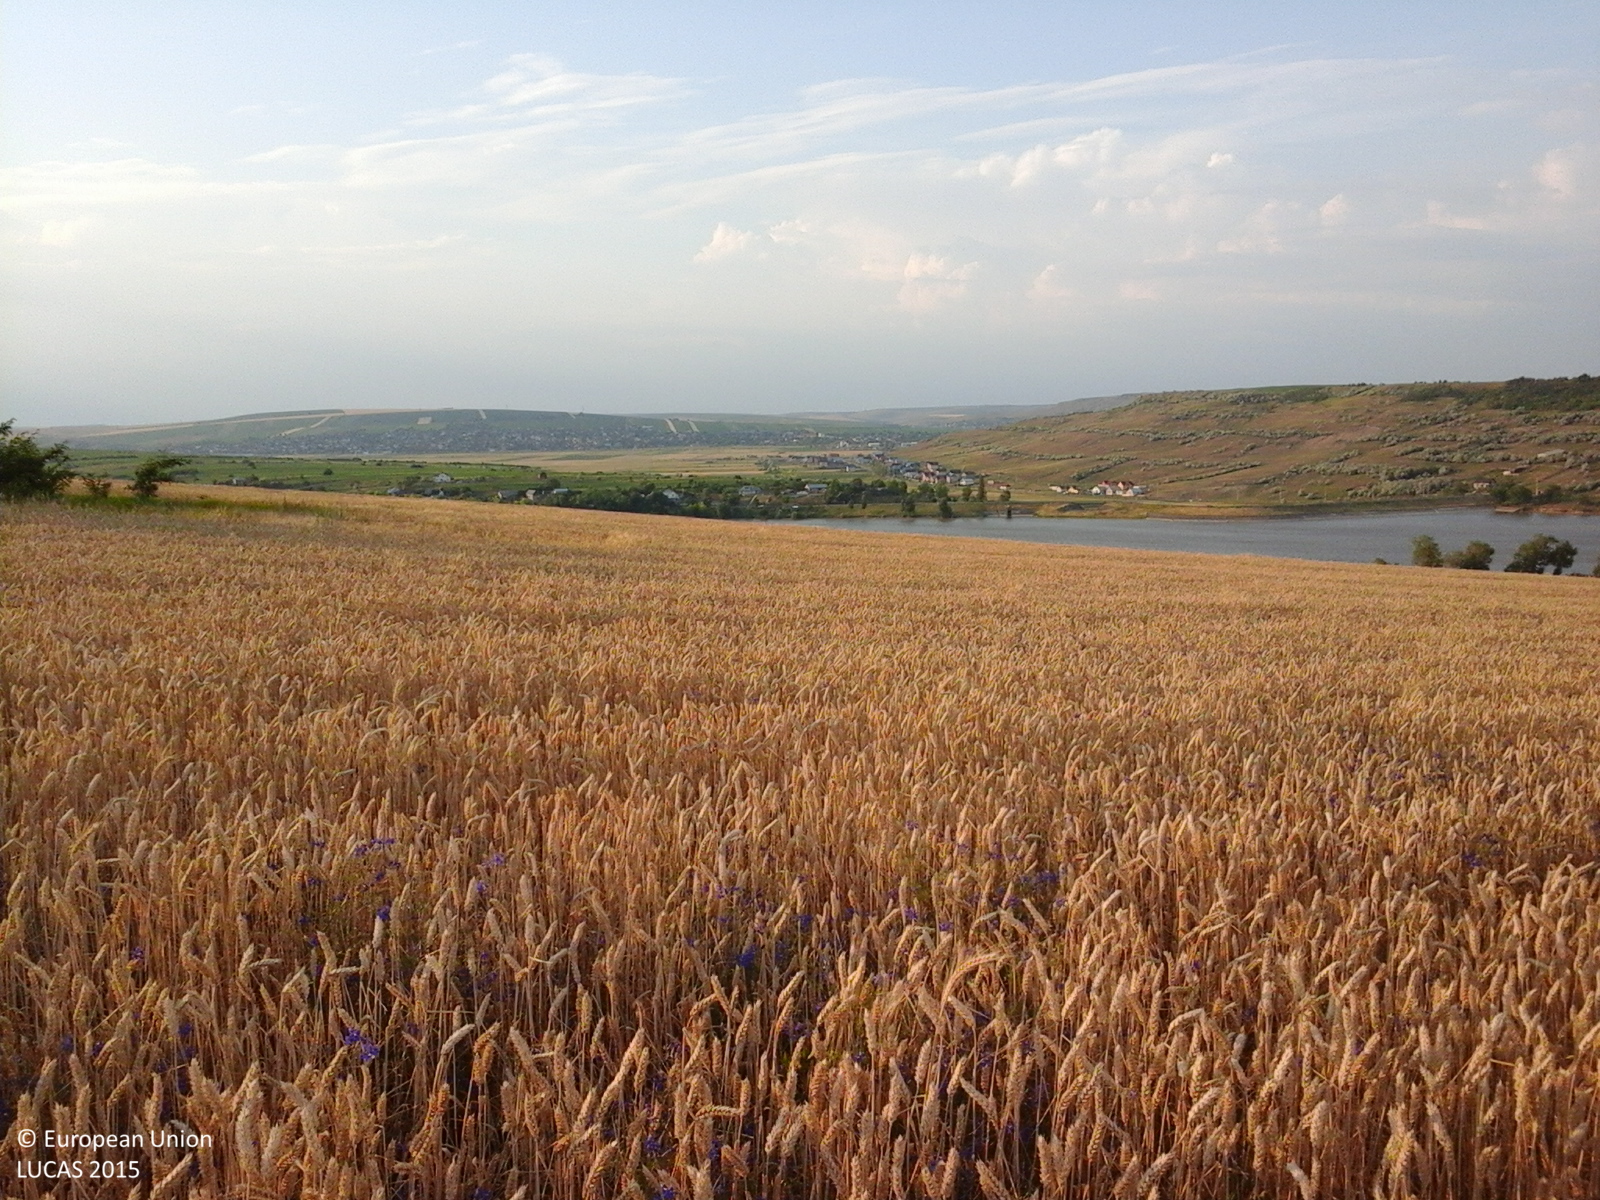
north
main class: Cropland
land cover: Common wheat
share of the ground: > 75 %
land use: Agriculture (excluding fallow land and kitchen gardens)
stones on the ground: < 10 %
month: June
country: RO
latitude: 47.1560
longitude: 27.4042
